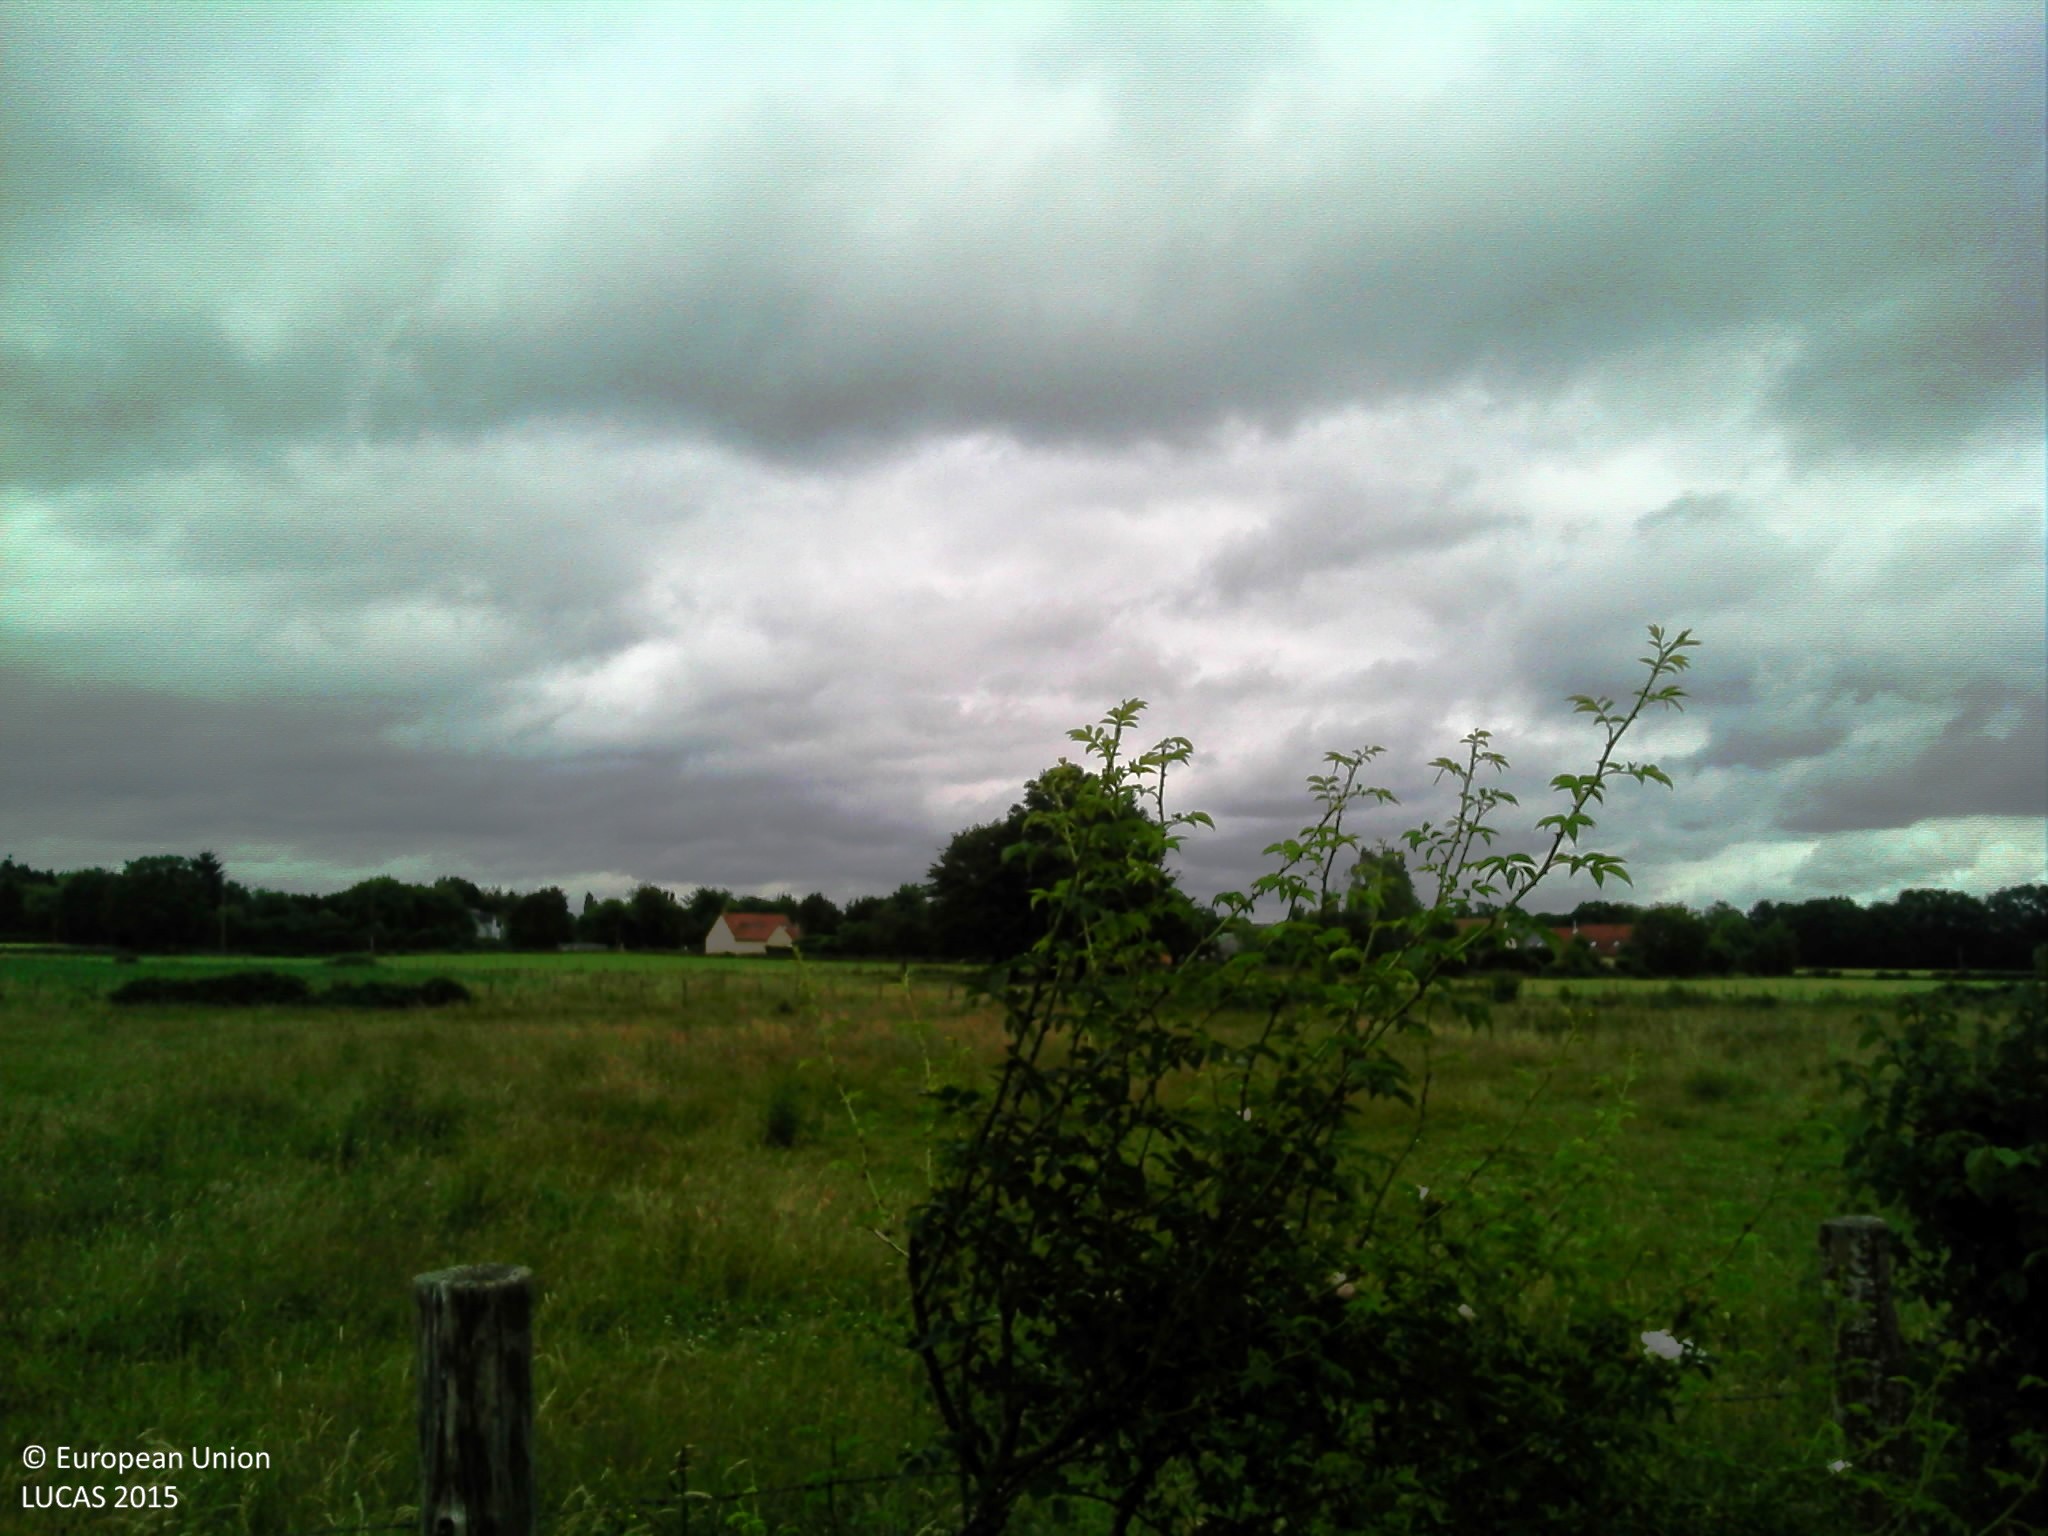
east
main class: Grassland
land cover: Grassland without tree/shrub cover
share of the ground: > 75 %
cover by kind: herbaceous plants 100 %
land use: Agriculture (excluding fallow land and kitchen gardens)
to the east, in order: Grassland without tree/shrub cover; Fences; Maize; Fences; Grassland without tree/shrub cover; Fences; Grassland without tree/shrub cover
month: June
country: FR
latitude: 48.0844
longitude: 0.2955
